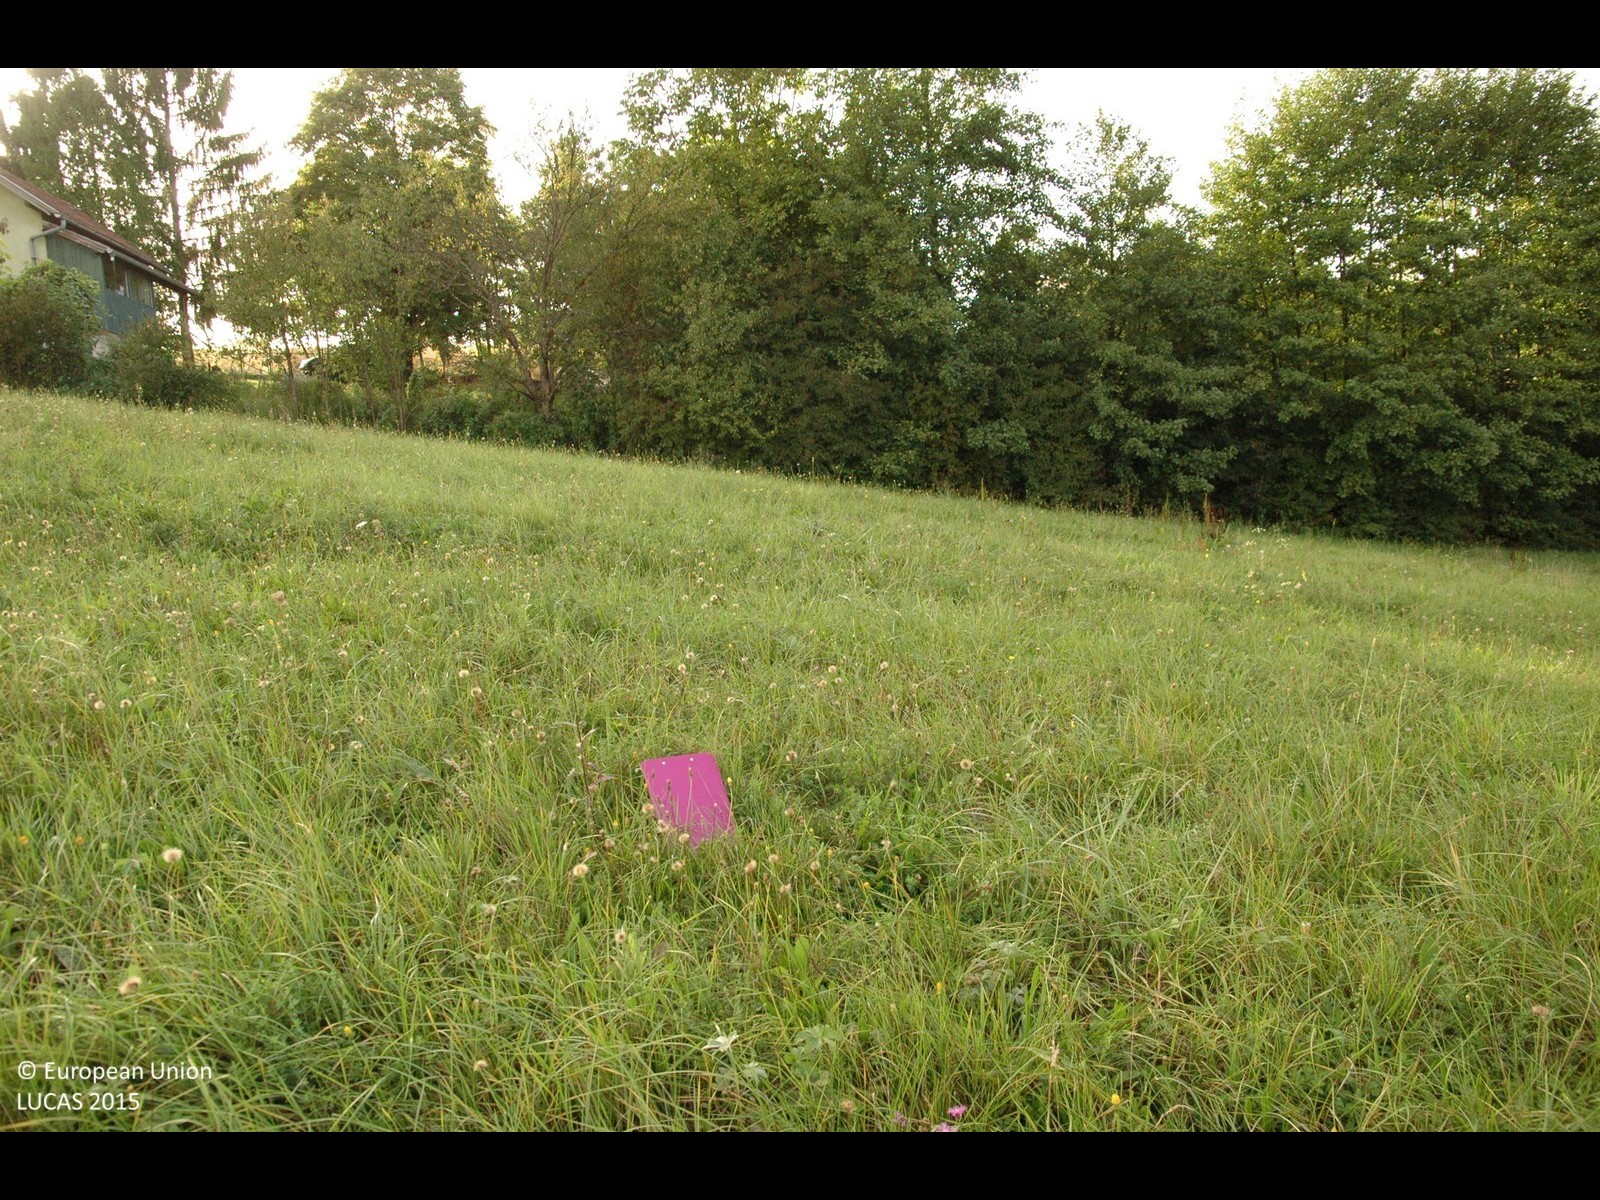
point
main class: Grassland
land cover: Grassland without tree/shrub cover
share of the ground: > 75 %
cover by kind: herbaceous plants 100 %
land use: Agriculture (excluding fallow land and kitchen gardens)
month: September
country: HR
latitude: 45.6444
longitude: 15.9378
